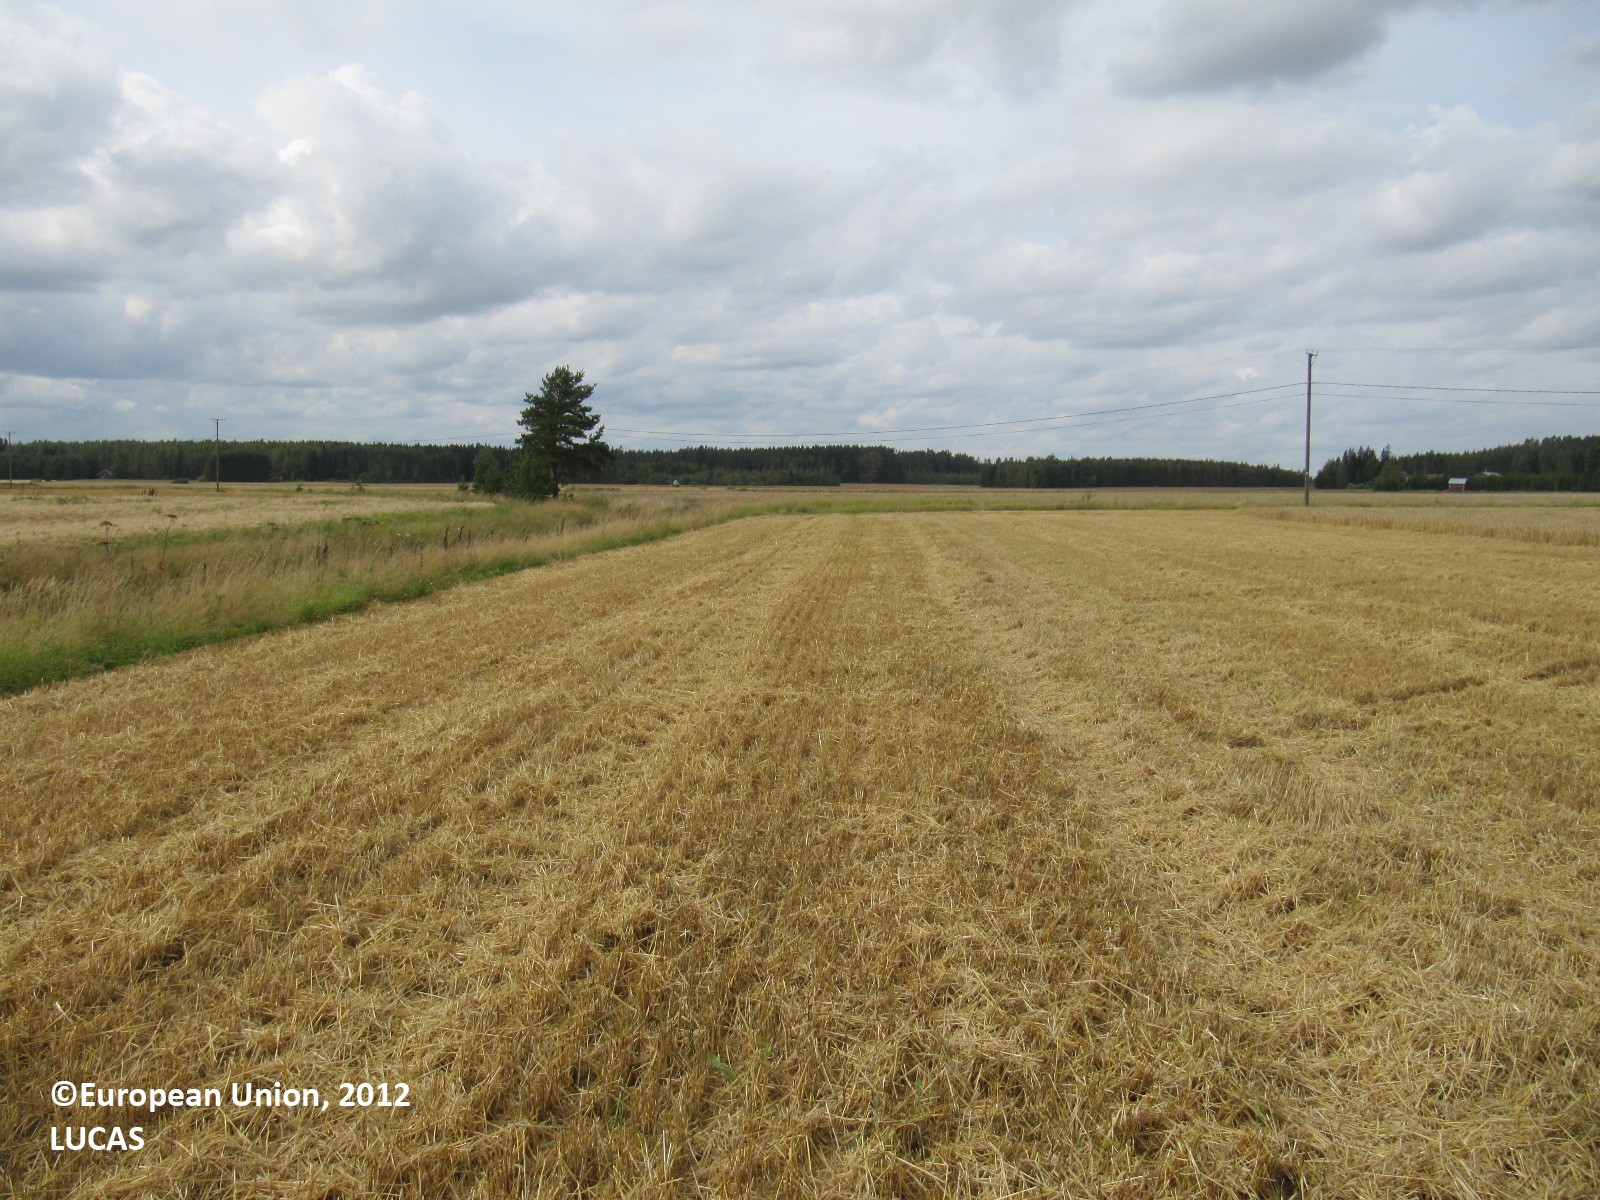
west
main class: Cropland
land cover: Barley
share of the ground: > 75 %
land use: Agriculture (excluding fallow land and kitchen gardens)
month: August
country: FI
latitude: 60.9028
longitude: 22.8855
